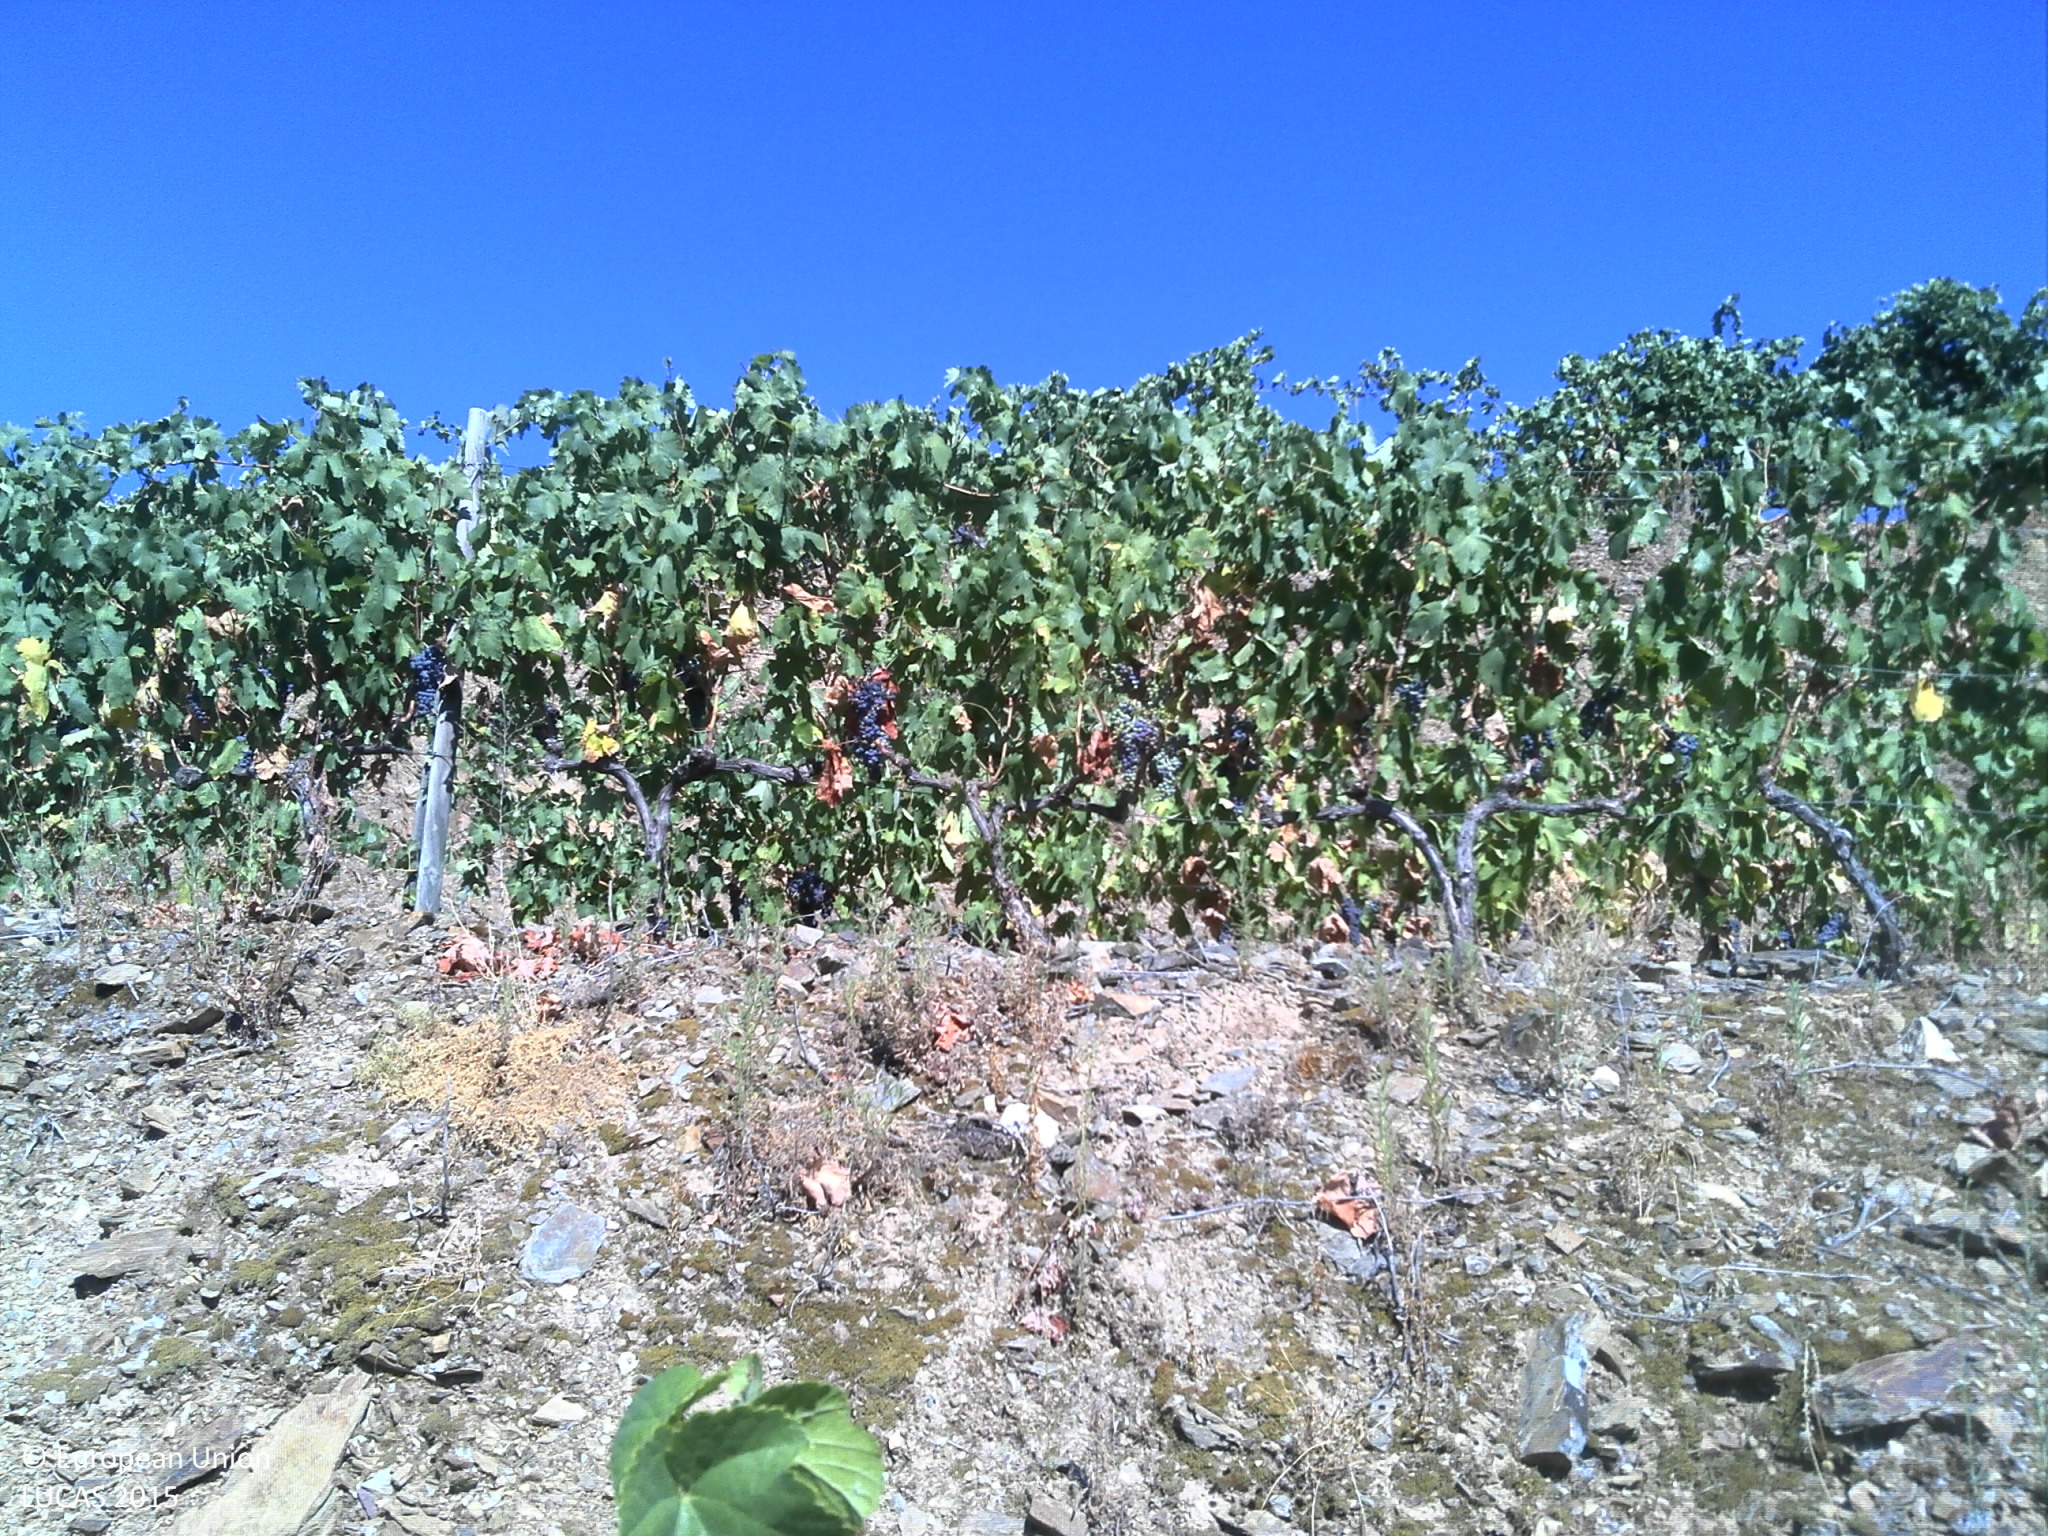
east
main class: Cropland
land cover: Vineyards
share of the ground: 25 - 50 %
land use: Agriculture (excluding fallow land and kitchen gardens)
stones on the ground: > 50 %
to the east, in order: Vineyards; Tracks; Vineyards; Tracks; Vineyards; Tracks; Vineyards; Tracks; Vineyards
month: July
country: PT
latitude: 41.1541
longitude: -7.2877
